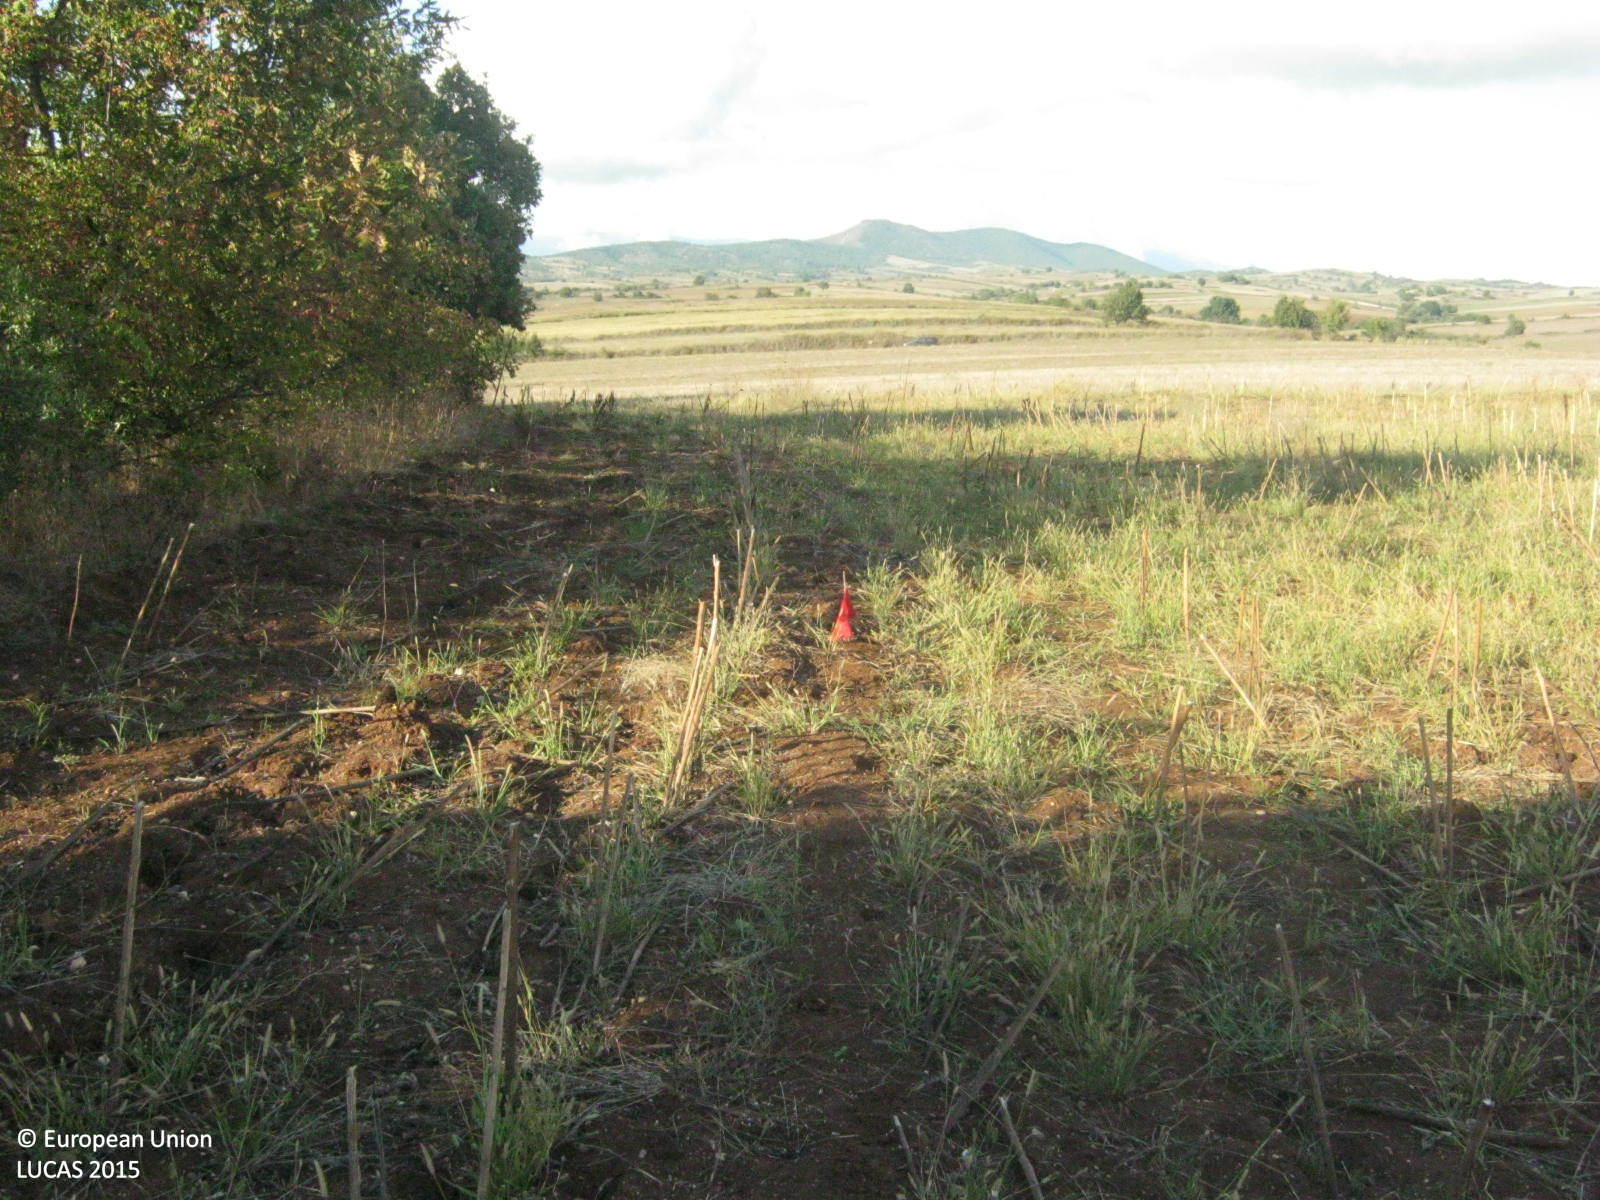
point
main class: Grassland
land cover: Spontaneously vegetated surfaces
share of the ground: > 75 %
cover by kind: herbaceous plants 70 %, consolidated bare surface 30 %
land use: Fallow land
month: September
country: GR
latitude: 41.0814
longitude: 22.9992
